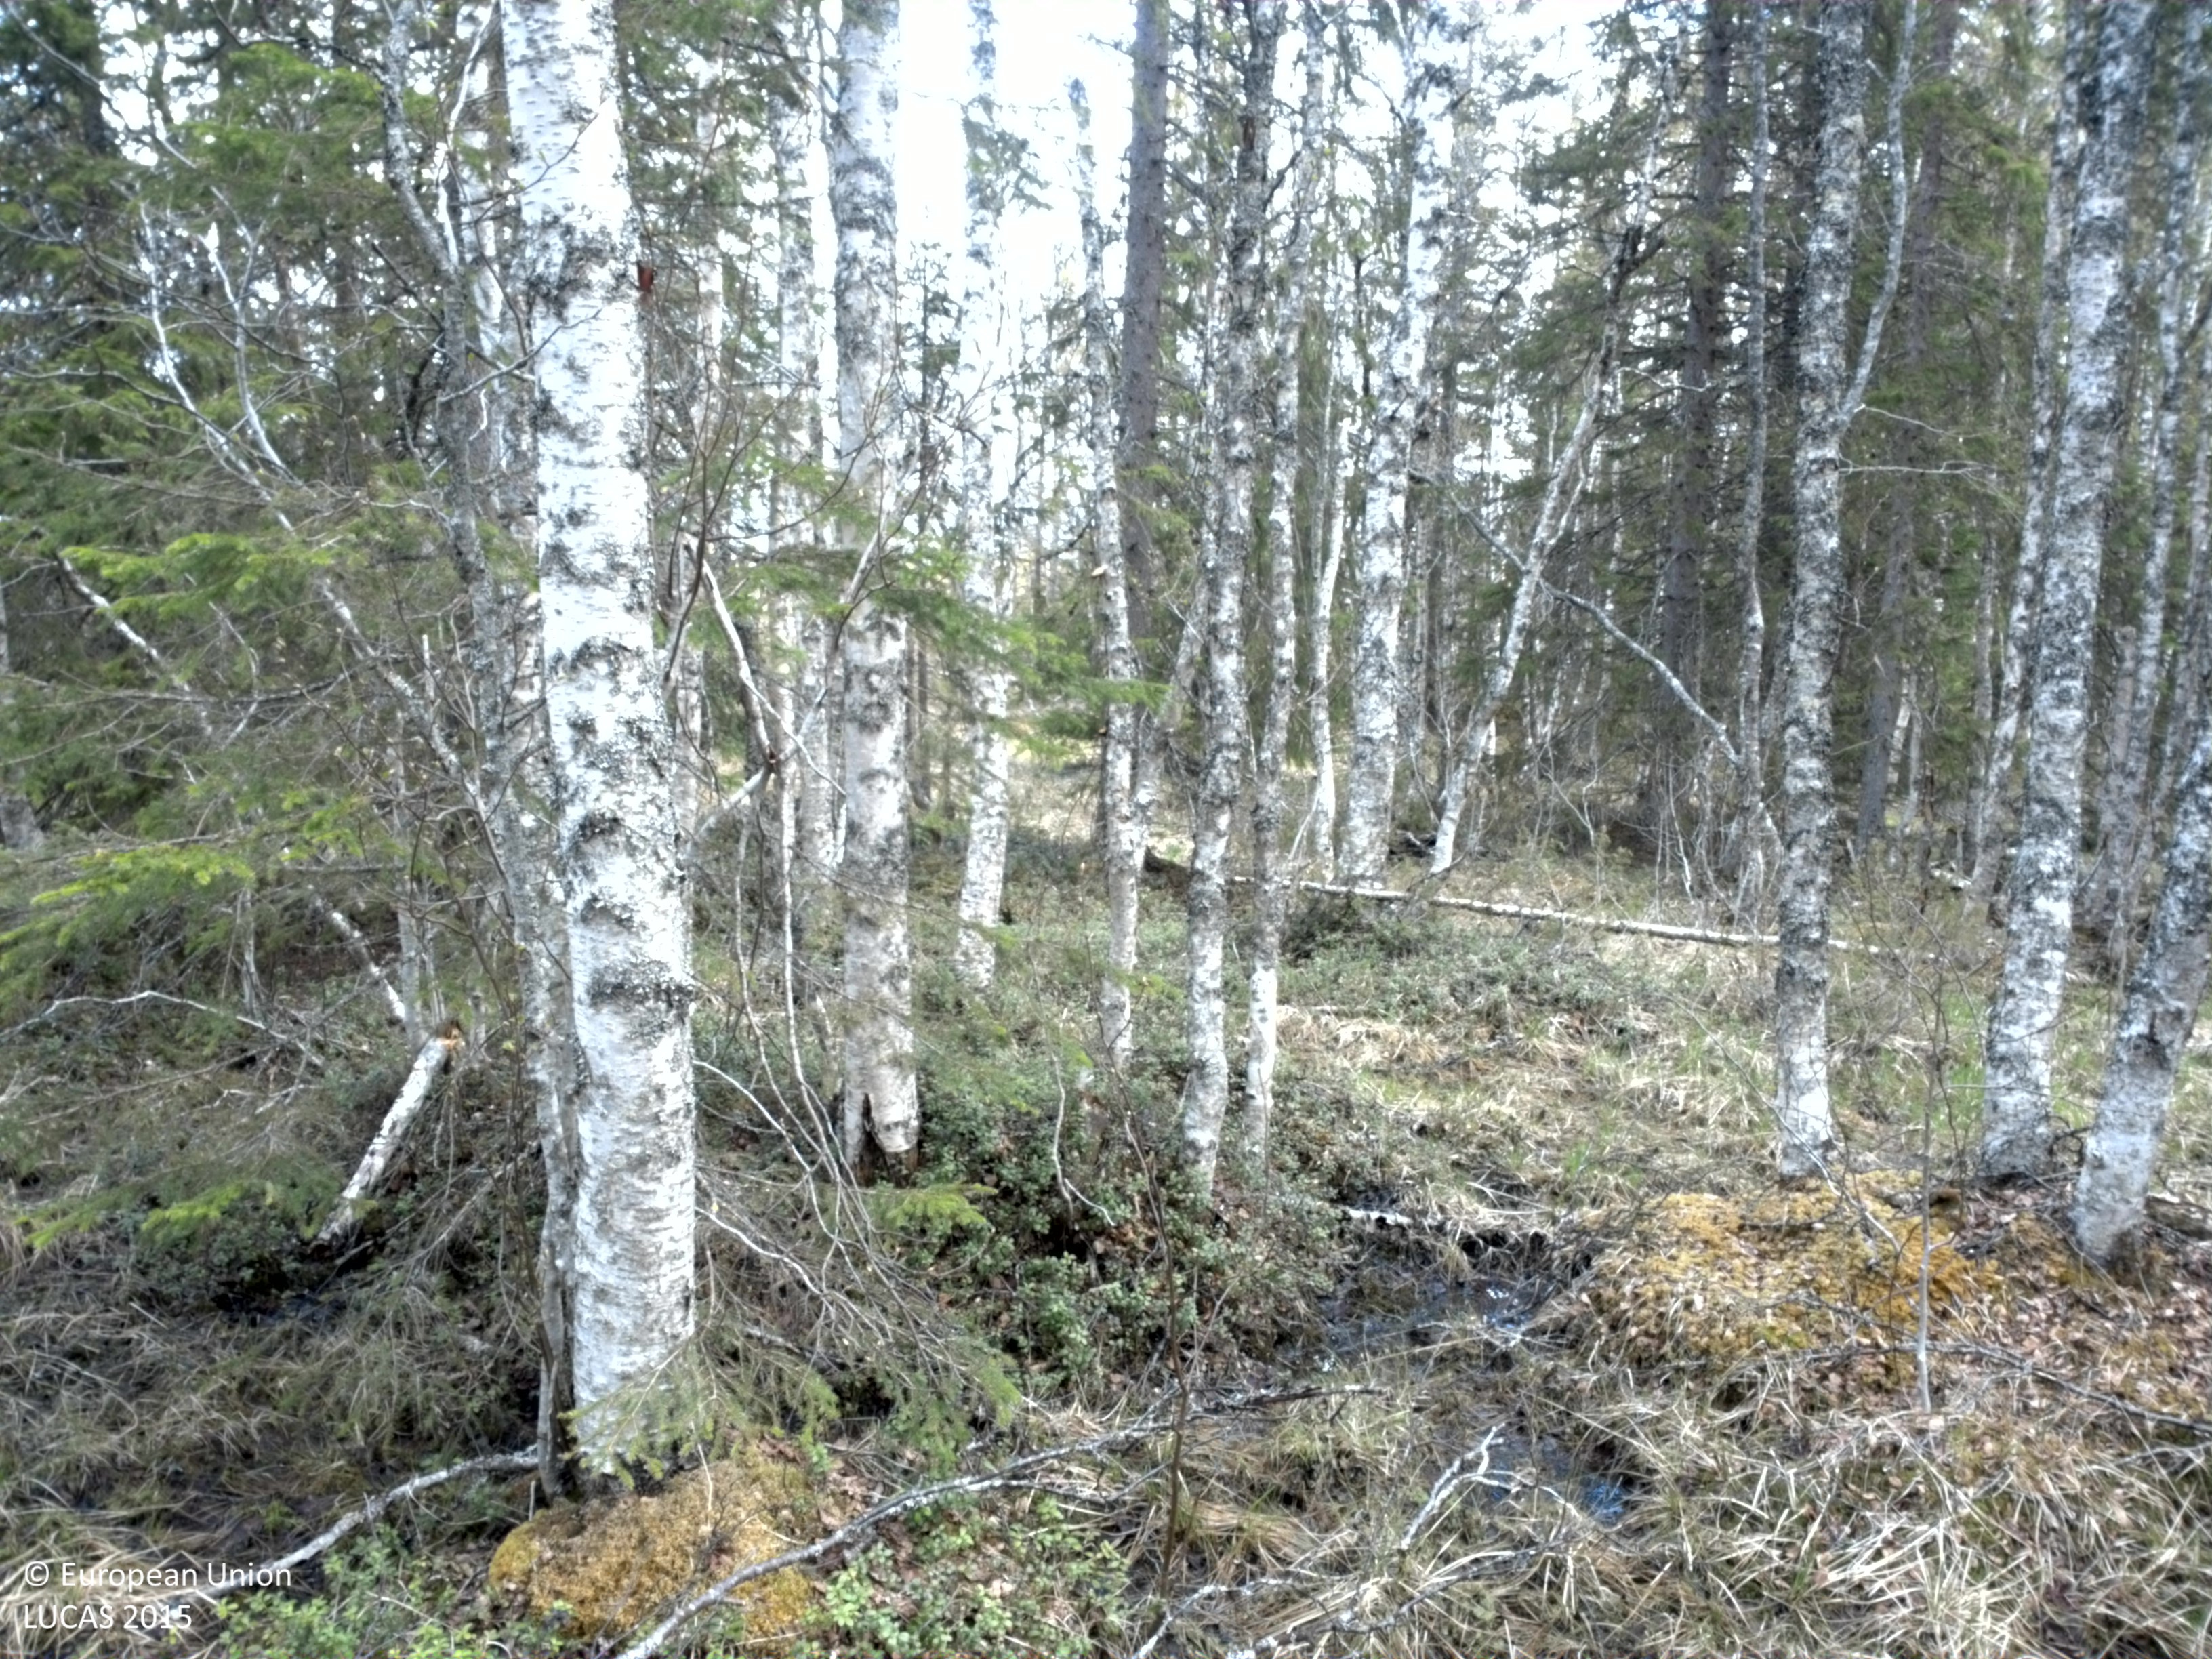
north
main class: Woodland
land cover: Spruce dominated mixed woodland
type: boreal forest
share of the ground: > 75 %
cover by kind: coniferous forest trees 65 %, broadleaved forest trees 25 %, shrubs 10 %
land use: Forestry
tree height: > 5 m
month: June
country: SE
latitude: 63.5218
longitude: 13.7799
